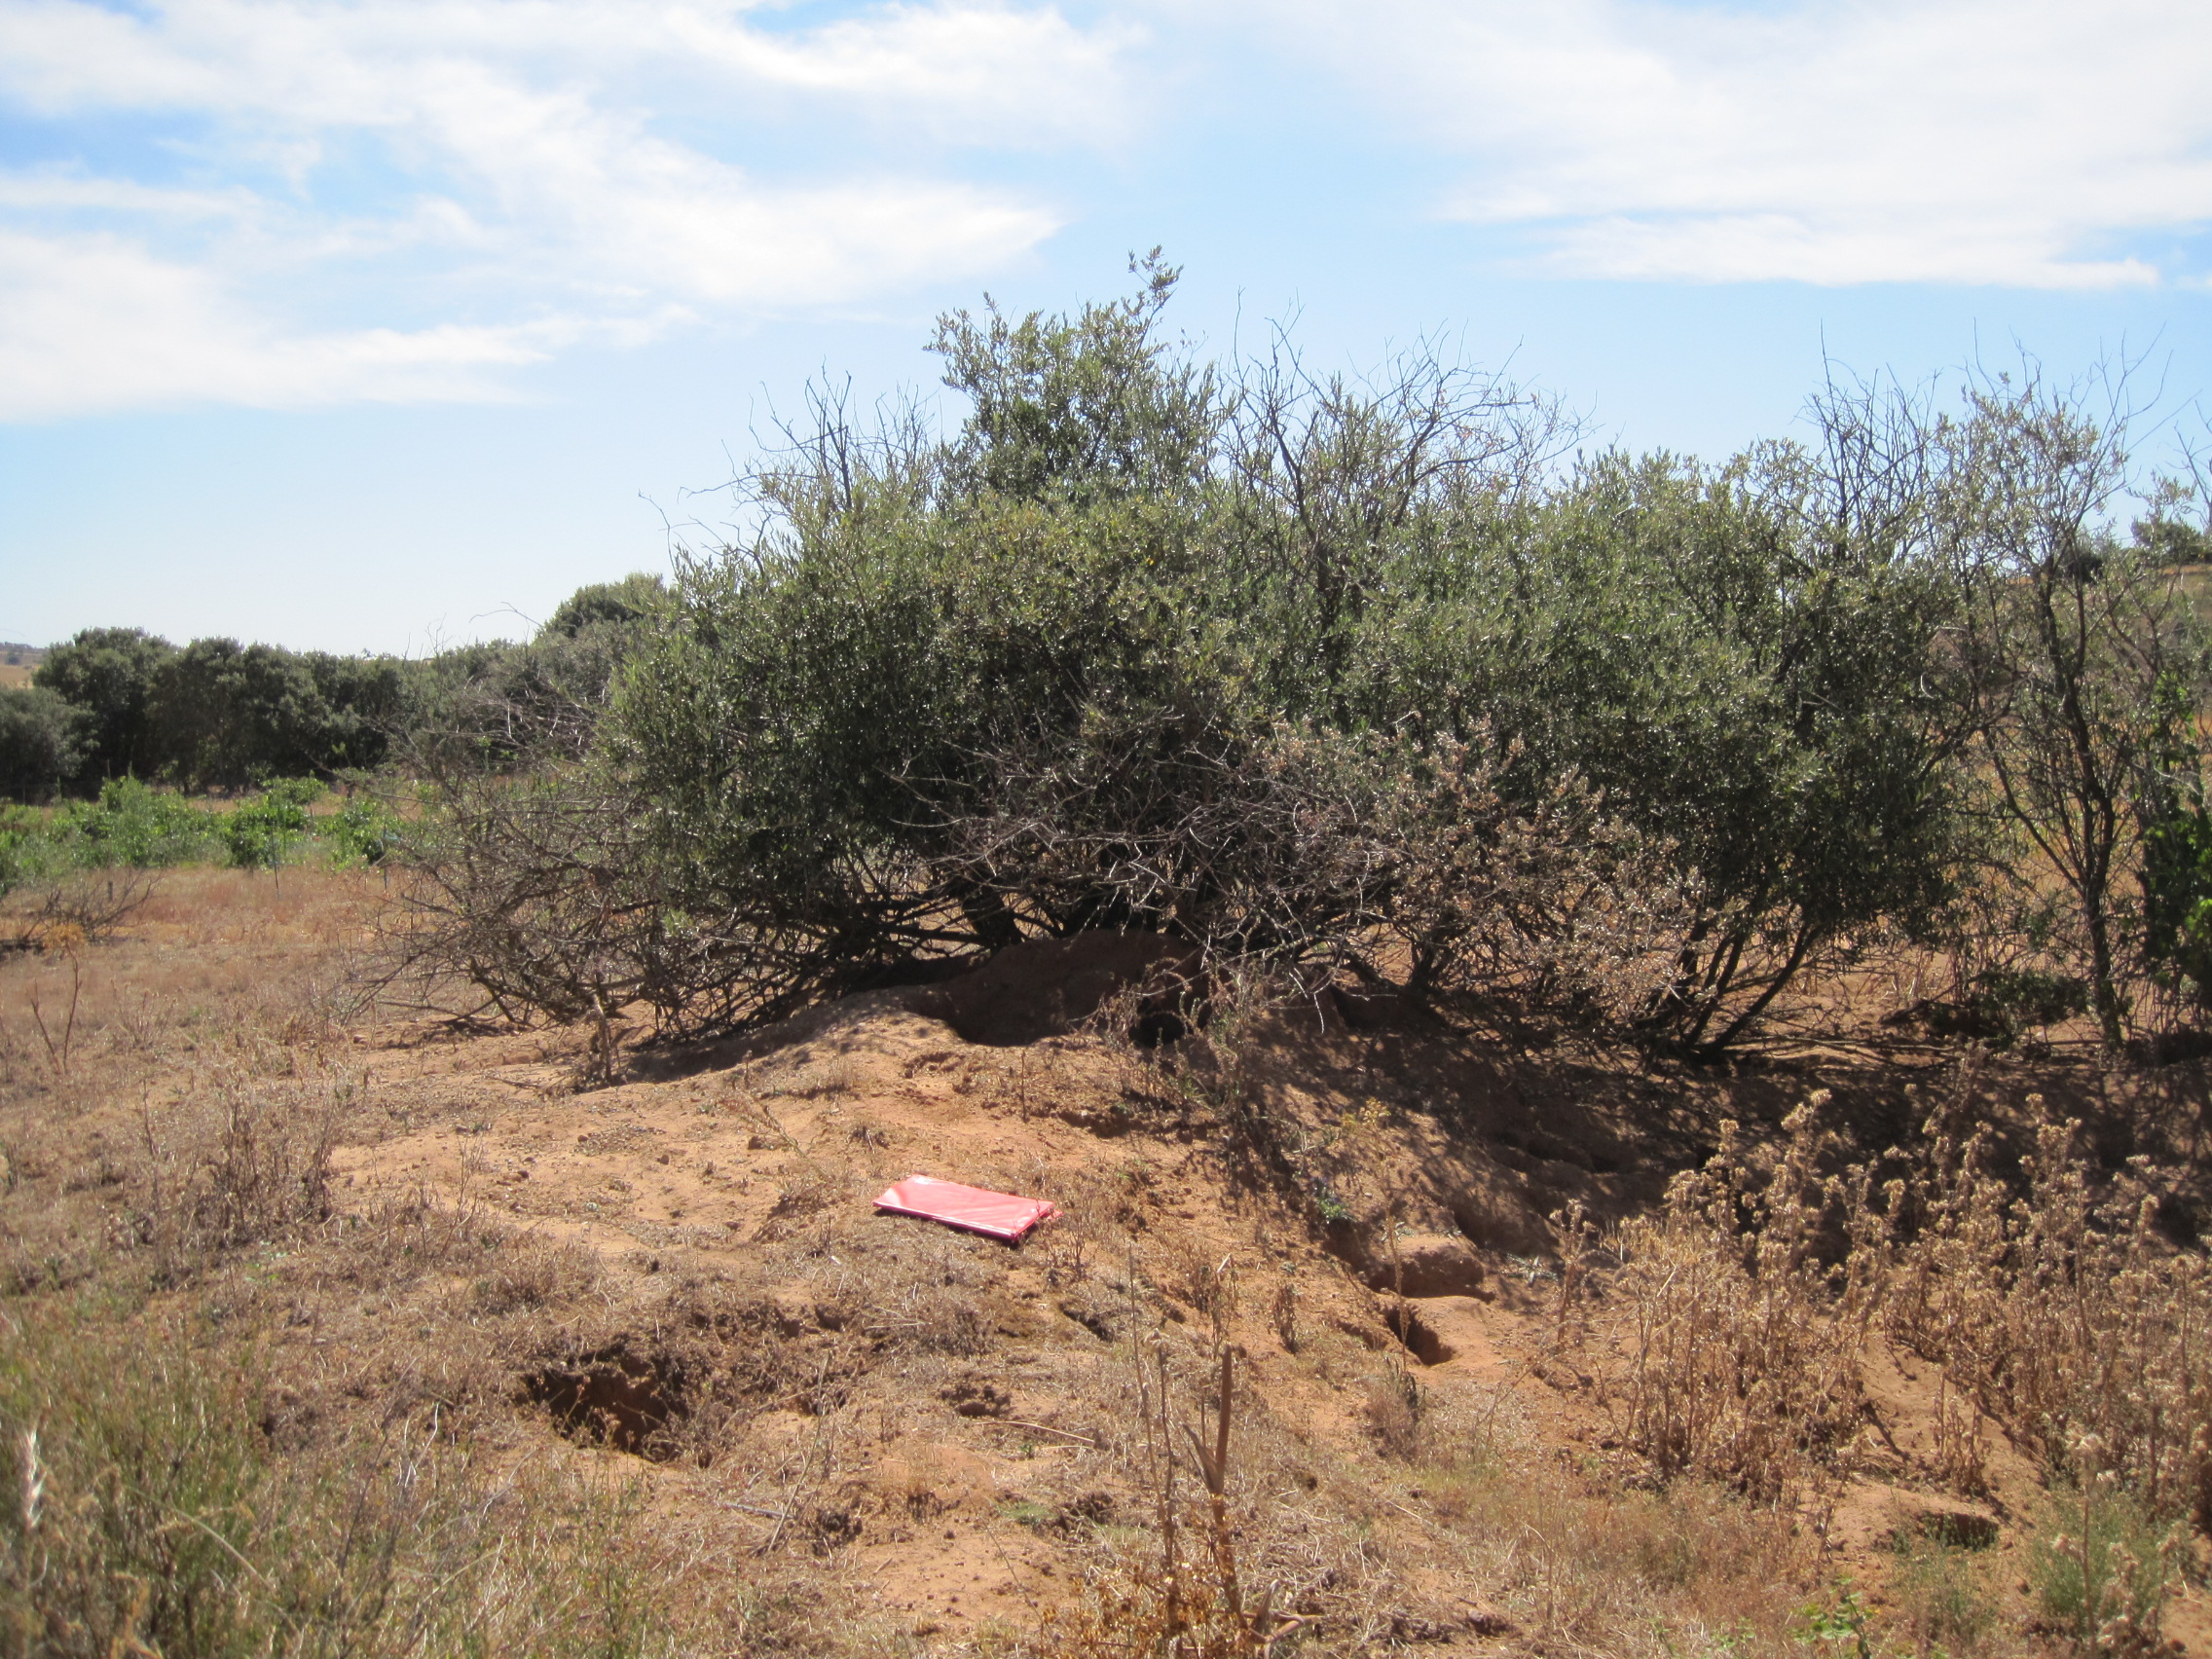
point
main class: Shrubland
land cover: Shrubland with sparse tree cover
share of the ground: 50 - 75 %
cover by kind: shrubs 50 %, herbaceous plants 35 %, unconsolidated bare surface 10 %, broadleaved forest trees 5 %
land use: Semi-natural and natural areas not in use
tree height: < 5 m
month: July
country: ES
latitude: 42.1498
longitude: -5.6183
